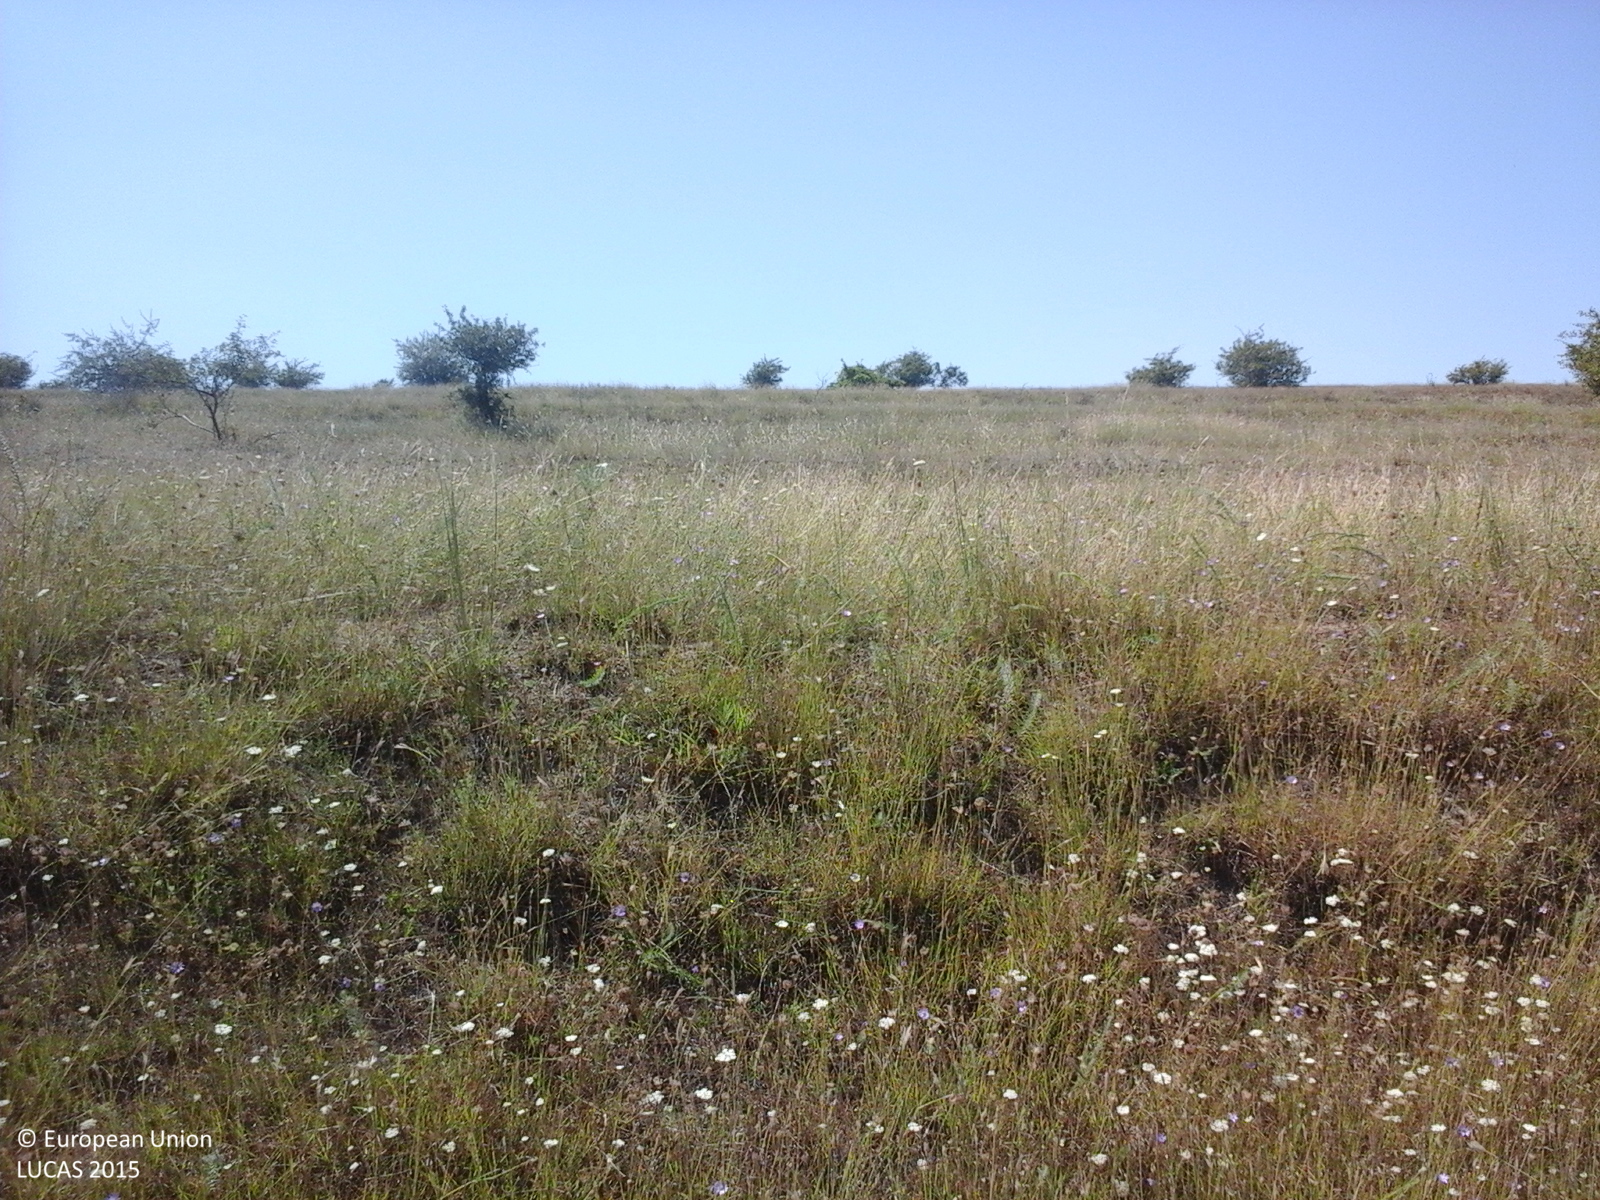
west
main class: Grassland
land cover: Grassland without tree/shrub cover
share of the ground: > 75 %
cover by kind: herbaceous plants 100 %
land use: Agriculture (excluding fallow land and kitchen gardens)
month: August
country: RO
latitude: 44.4329
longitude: 28.1384
